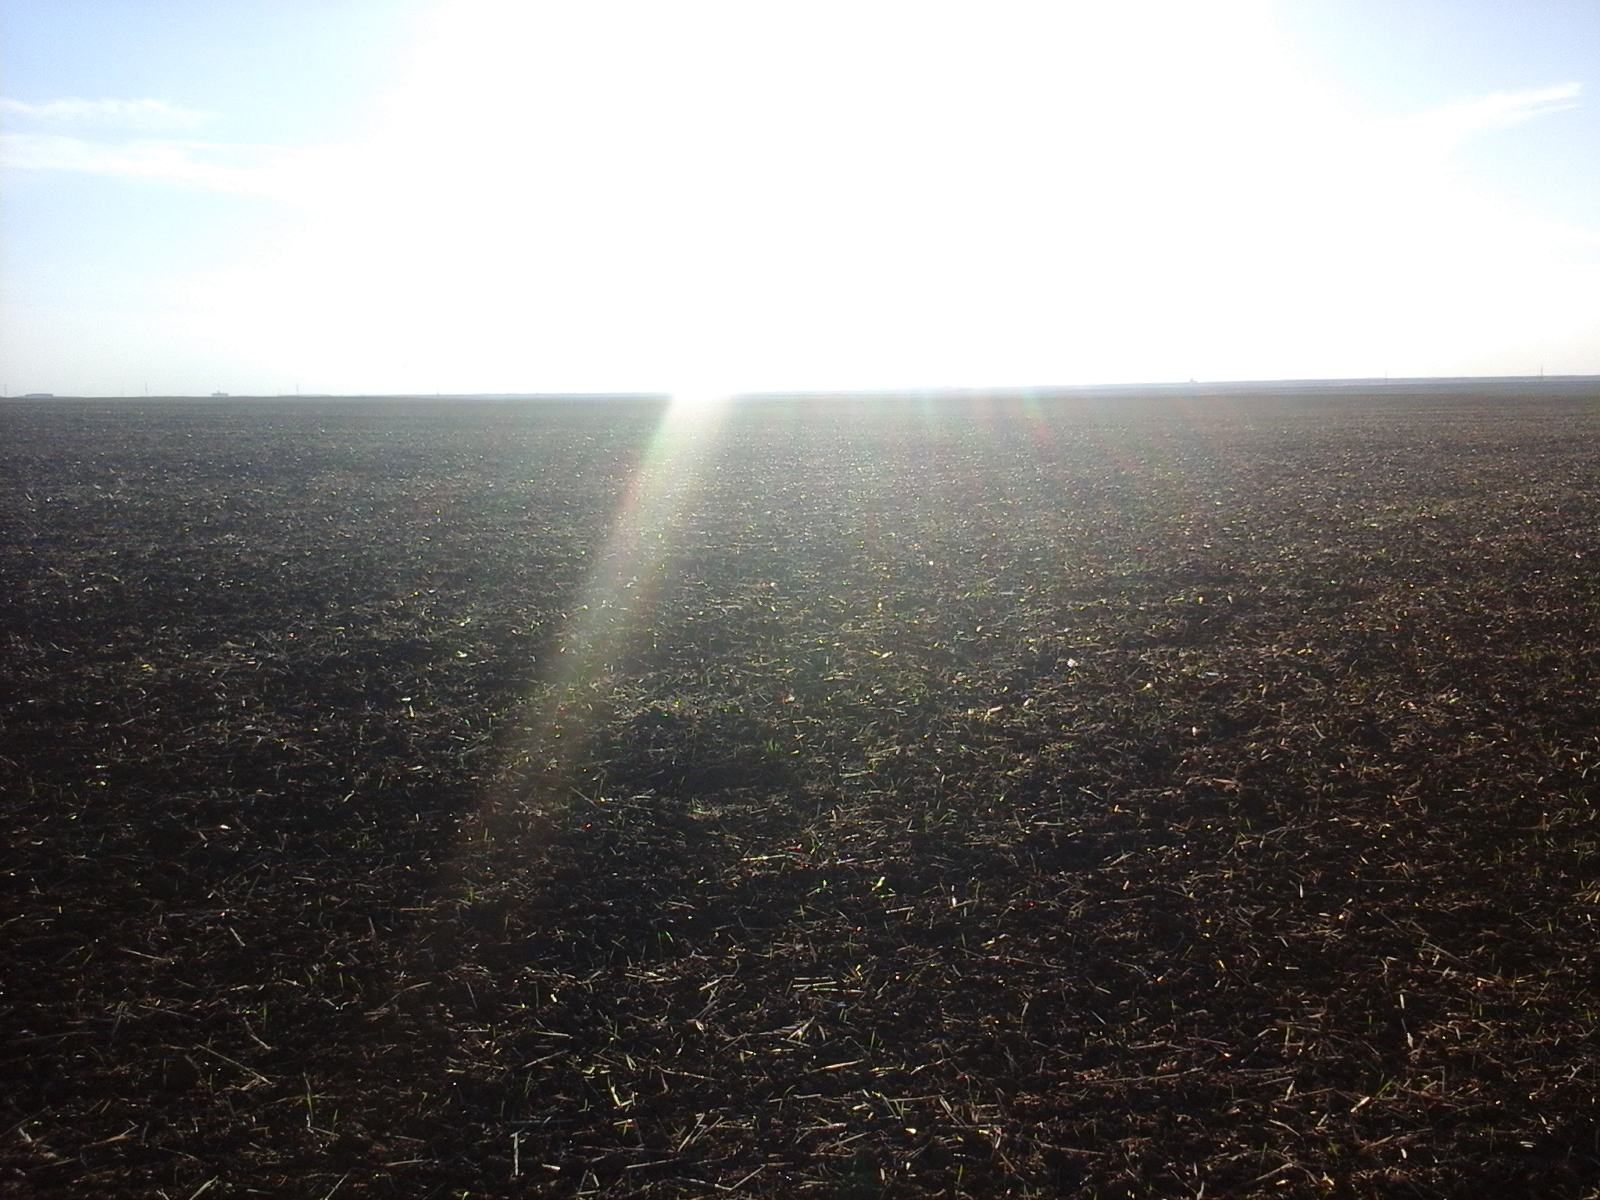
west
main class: Cropland
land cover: Common wheat
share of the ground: 10 - 25 %
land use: Agriculture (excluding fallow land and kitchen gardens)
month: August
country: RO
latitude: 46.0015
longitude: 21.3318
